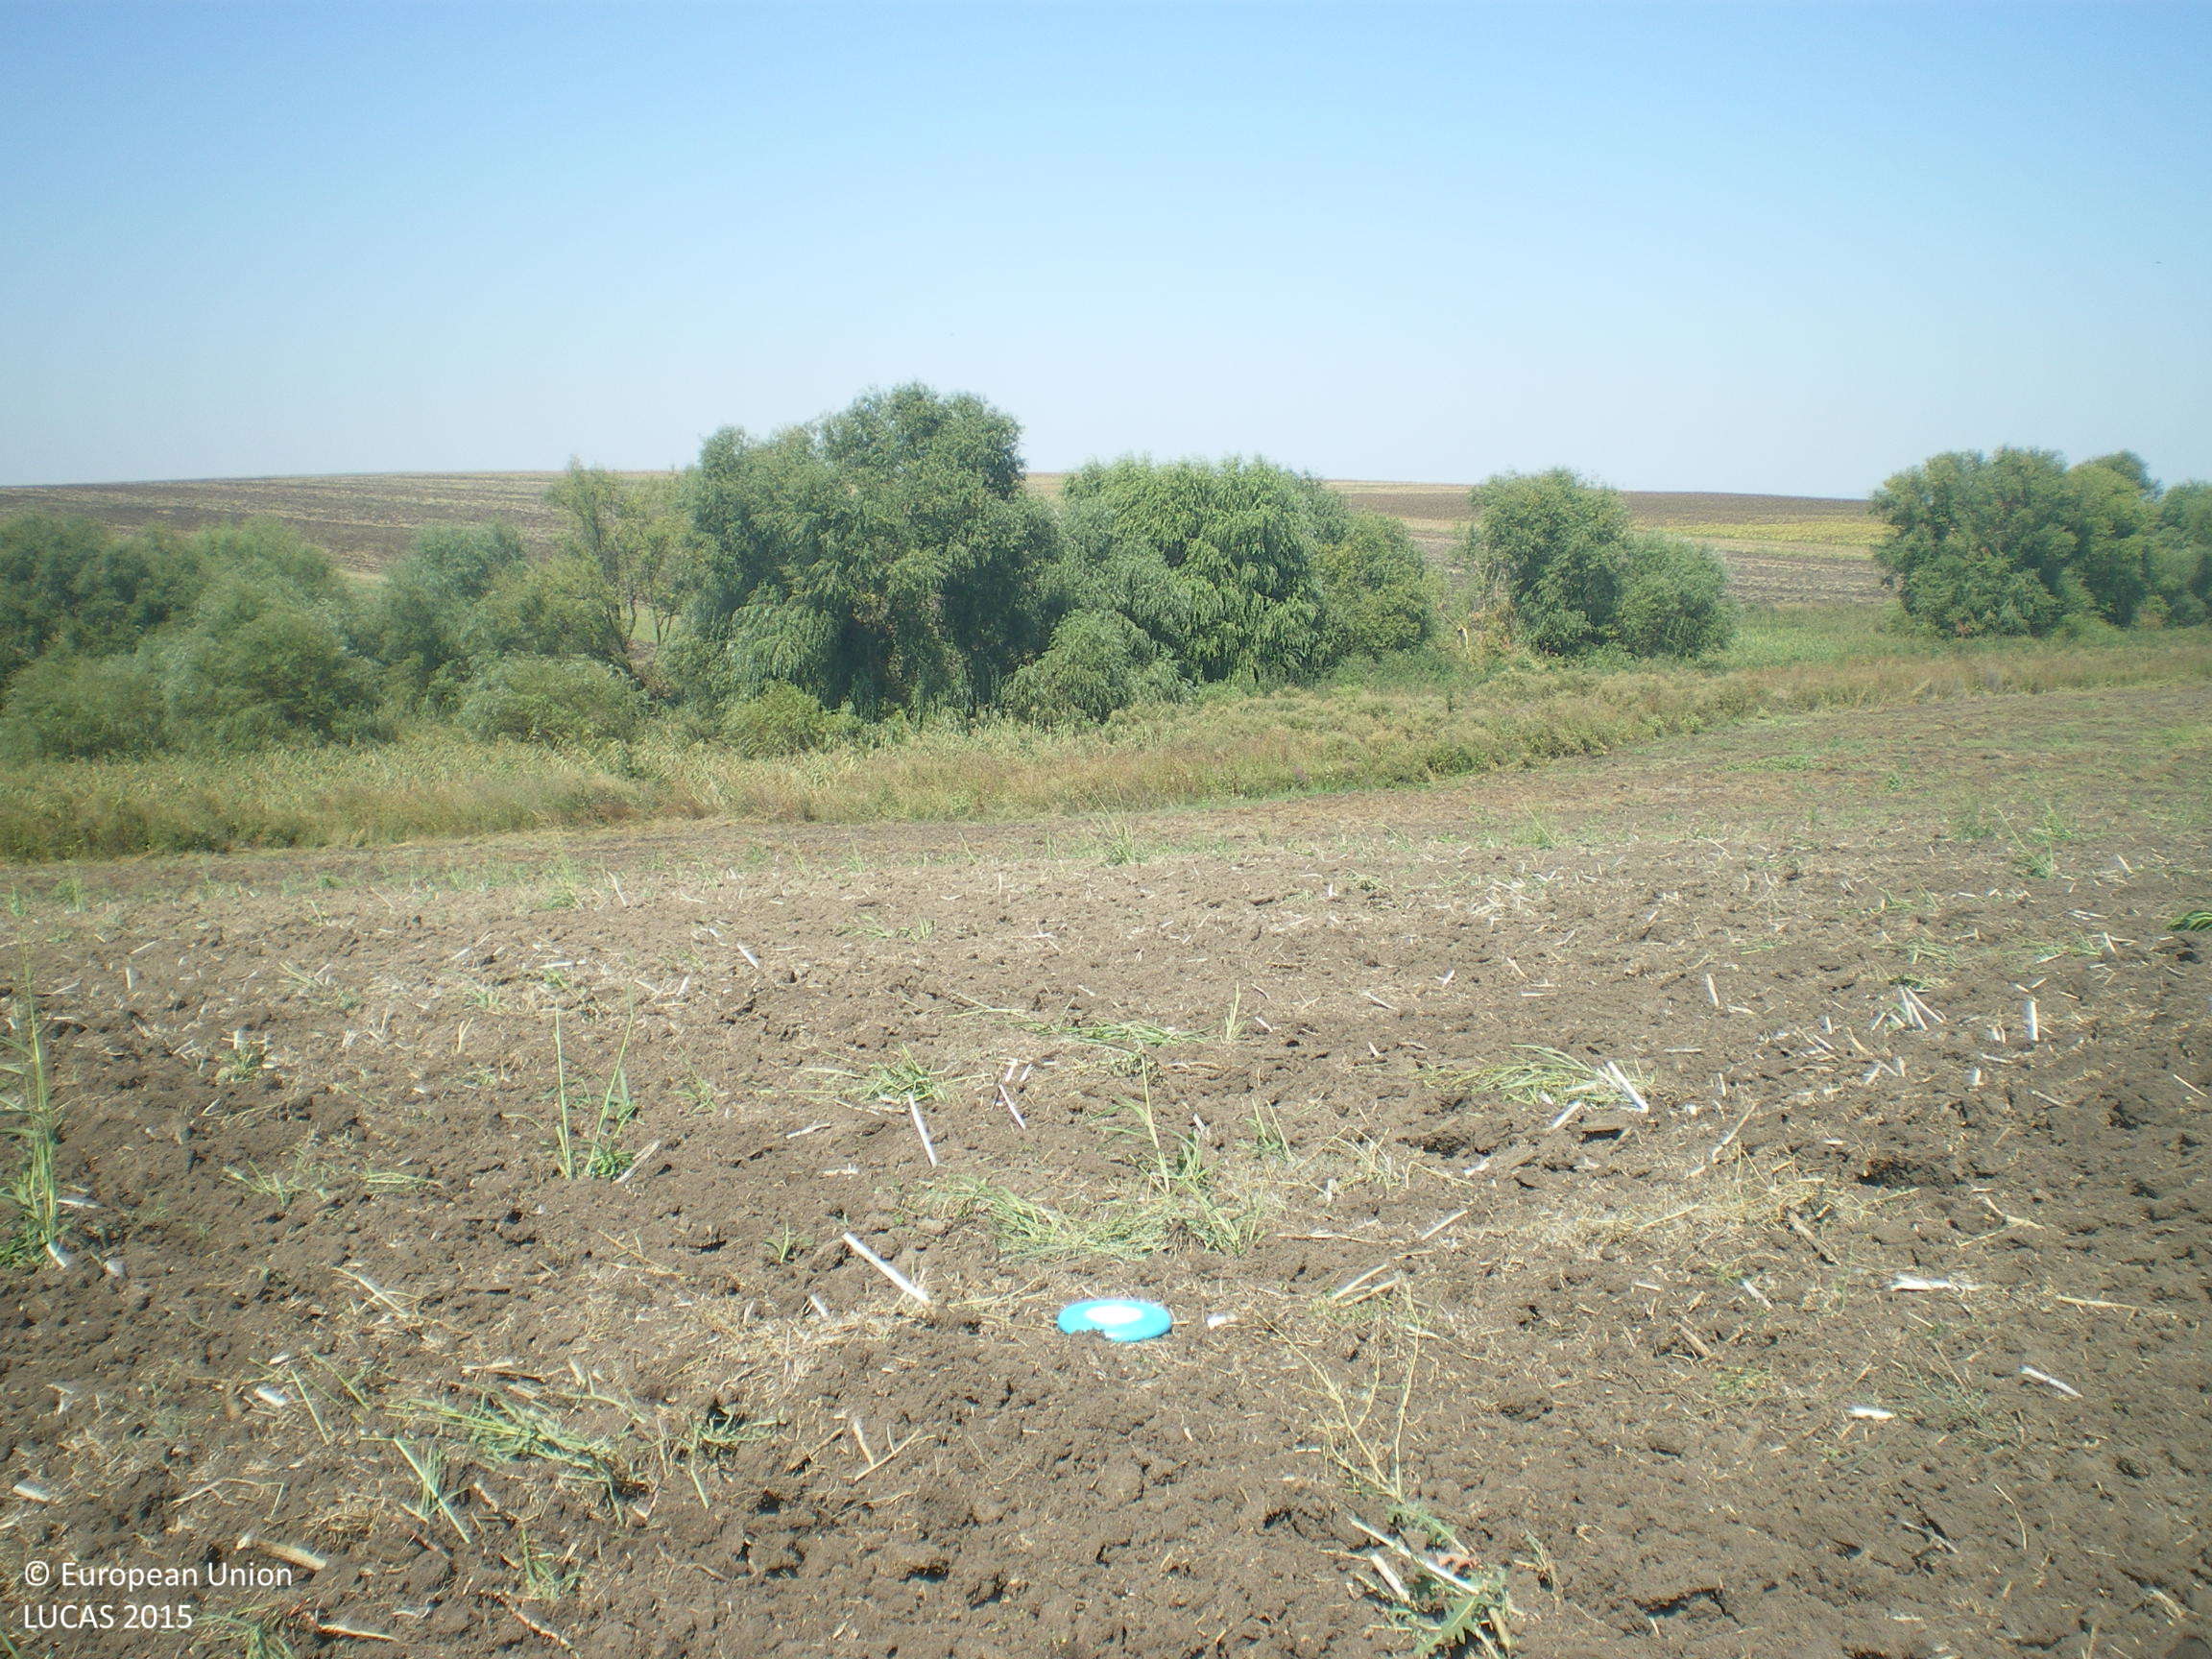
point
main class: Cropland
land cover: Rape and turnip rape
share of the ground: < 10 %
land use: Agriculture (excluding fallow land and kitchen gardens)
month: August
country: BG
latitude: 42.1423
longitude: 25.6658
